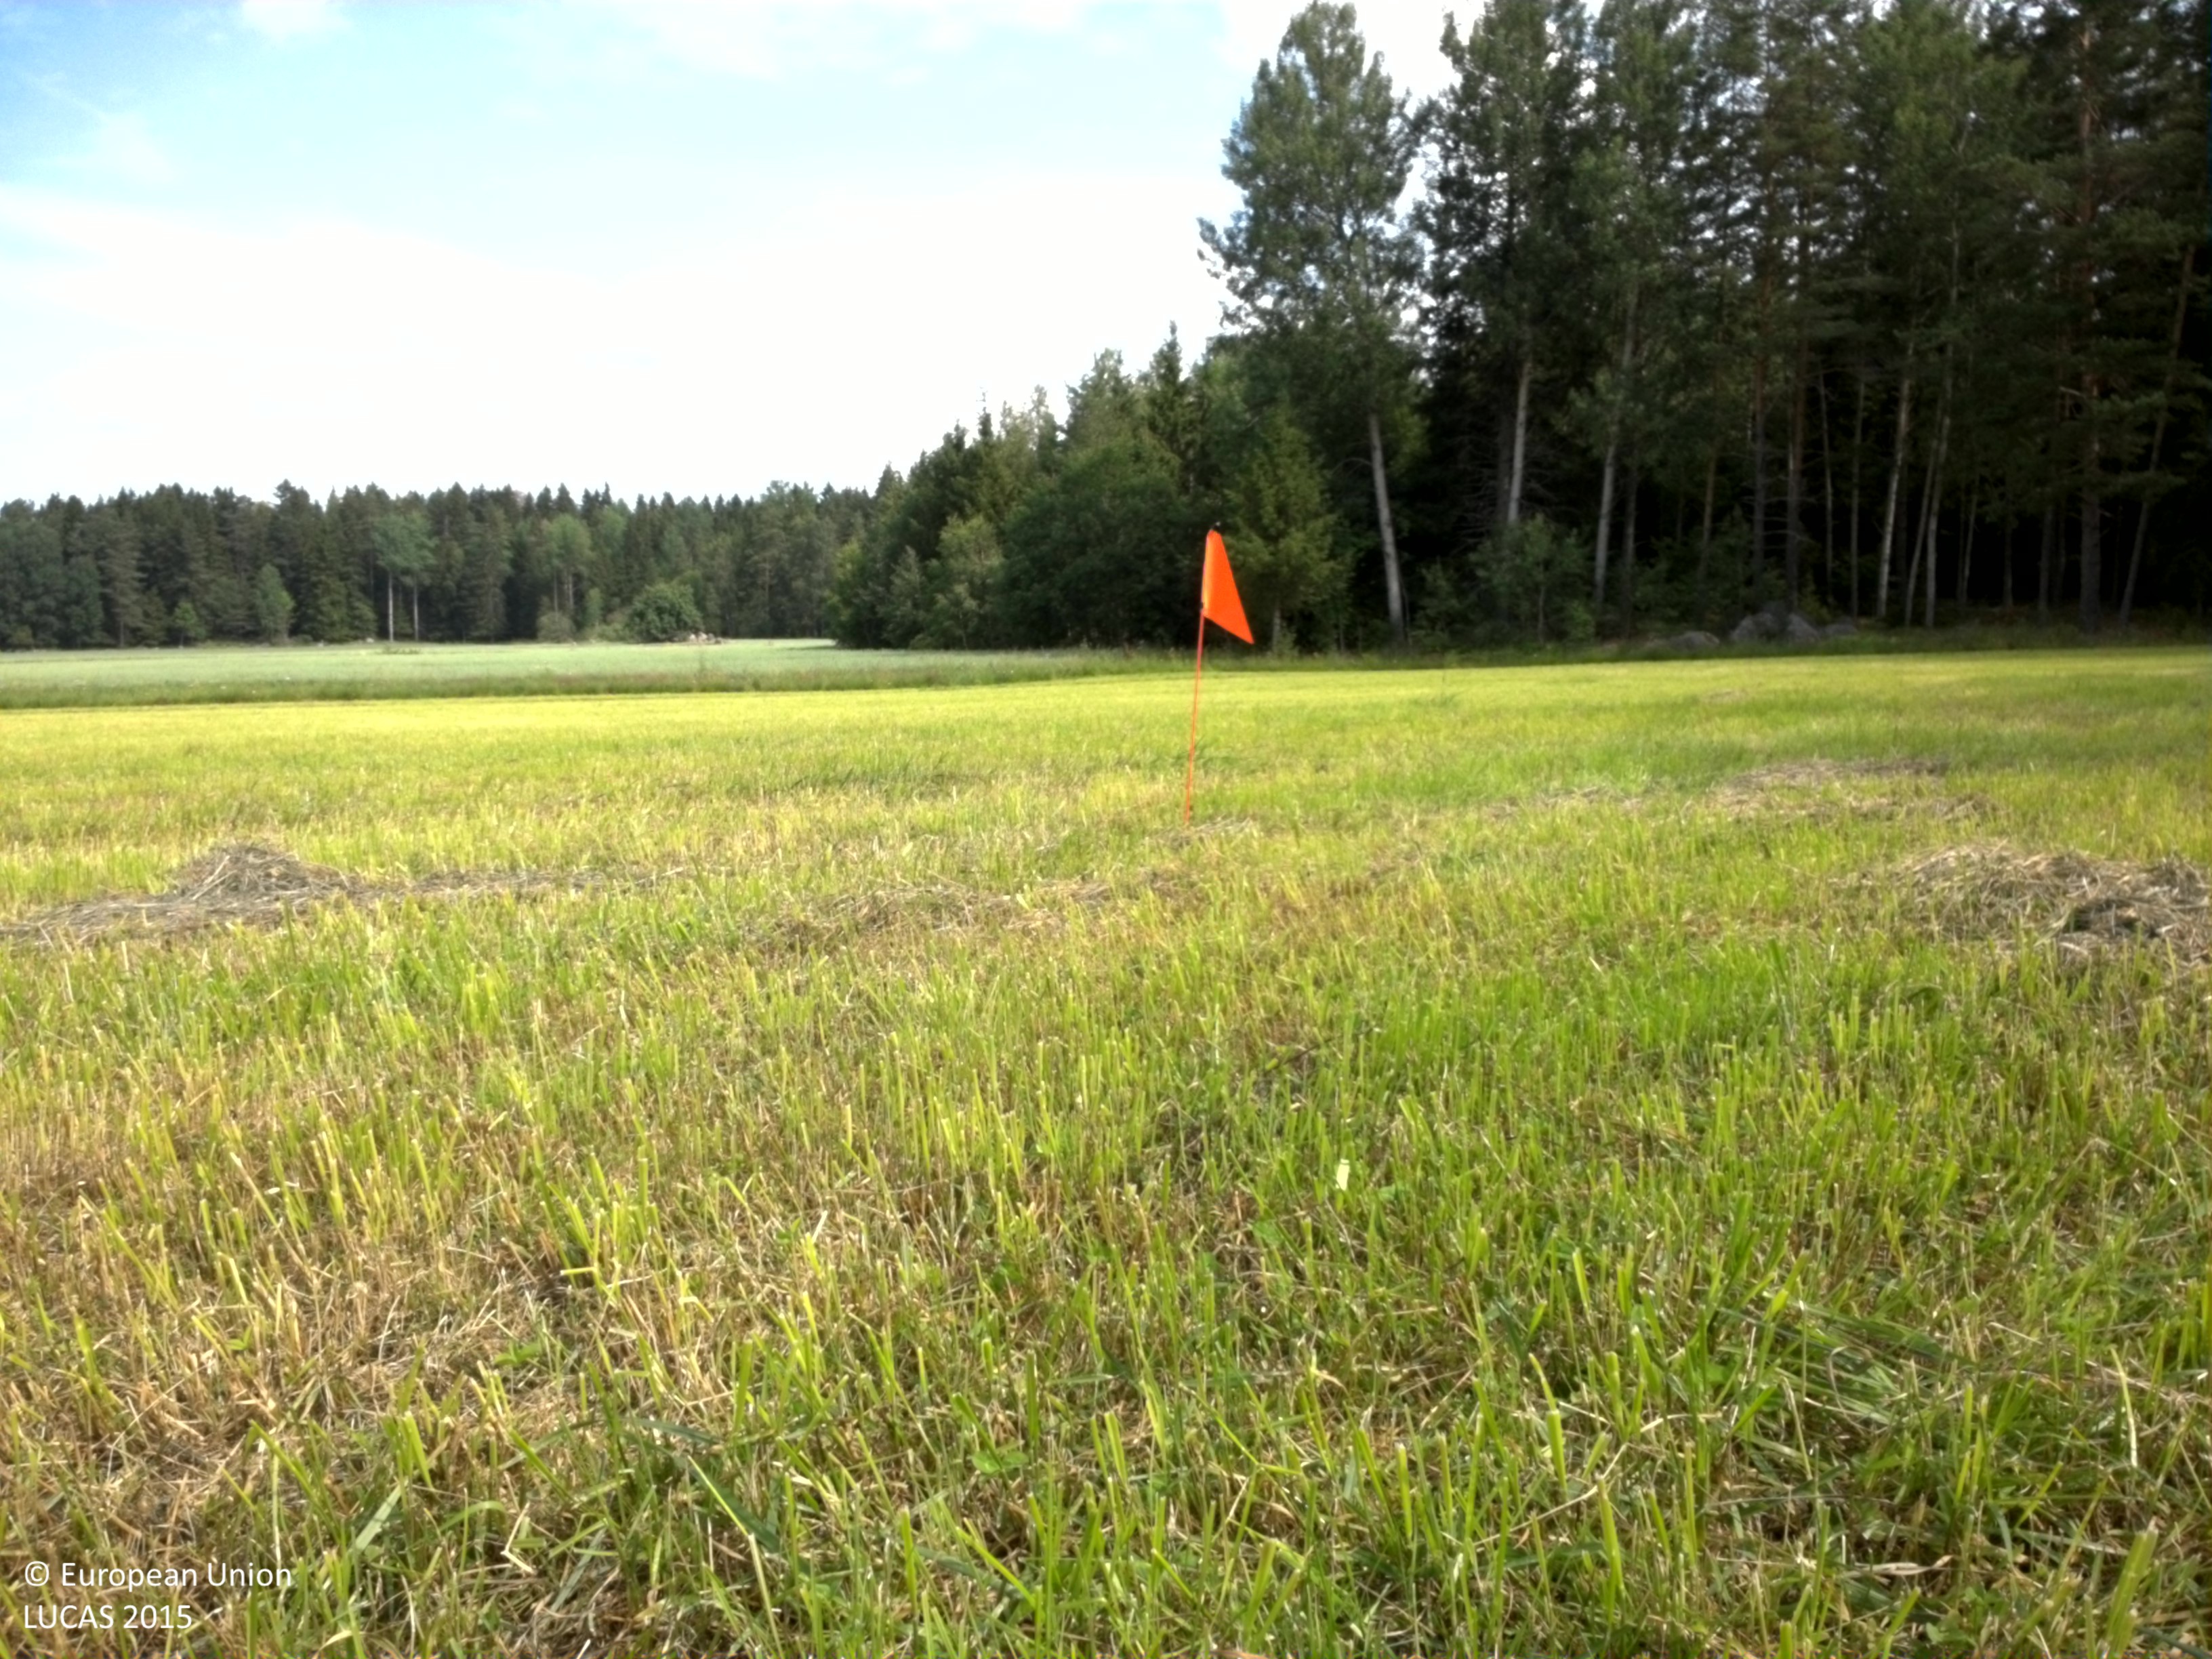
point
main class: Cropland
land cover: Other leguminous and mixtures for fodder
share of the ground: 10 - 25 %
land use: Agriculture (excluding fallow land and kitchen gardens)
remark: Harvested field
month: July
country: SE
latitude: 59.9891
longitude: 18.6199
